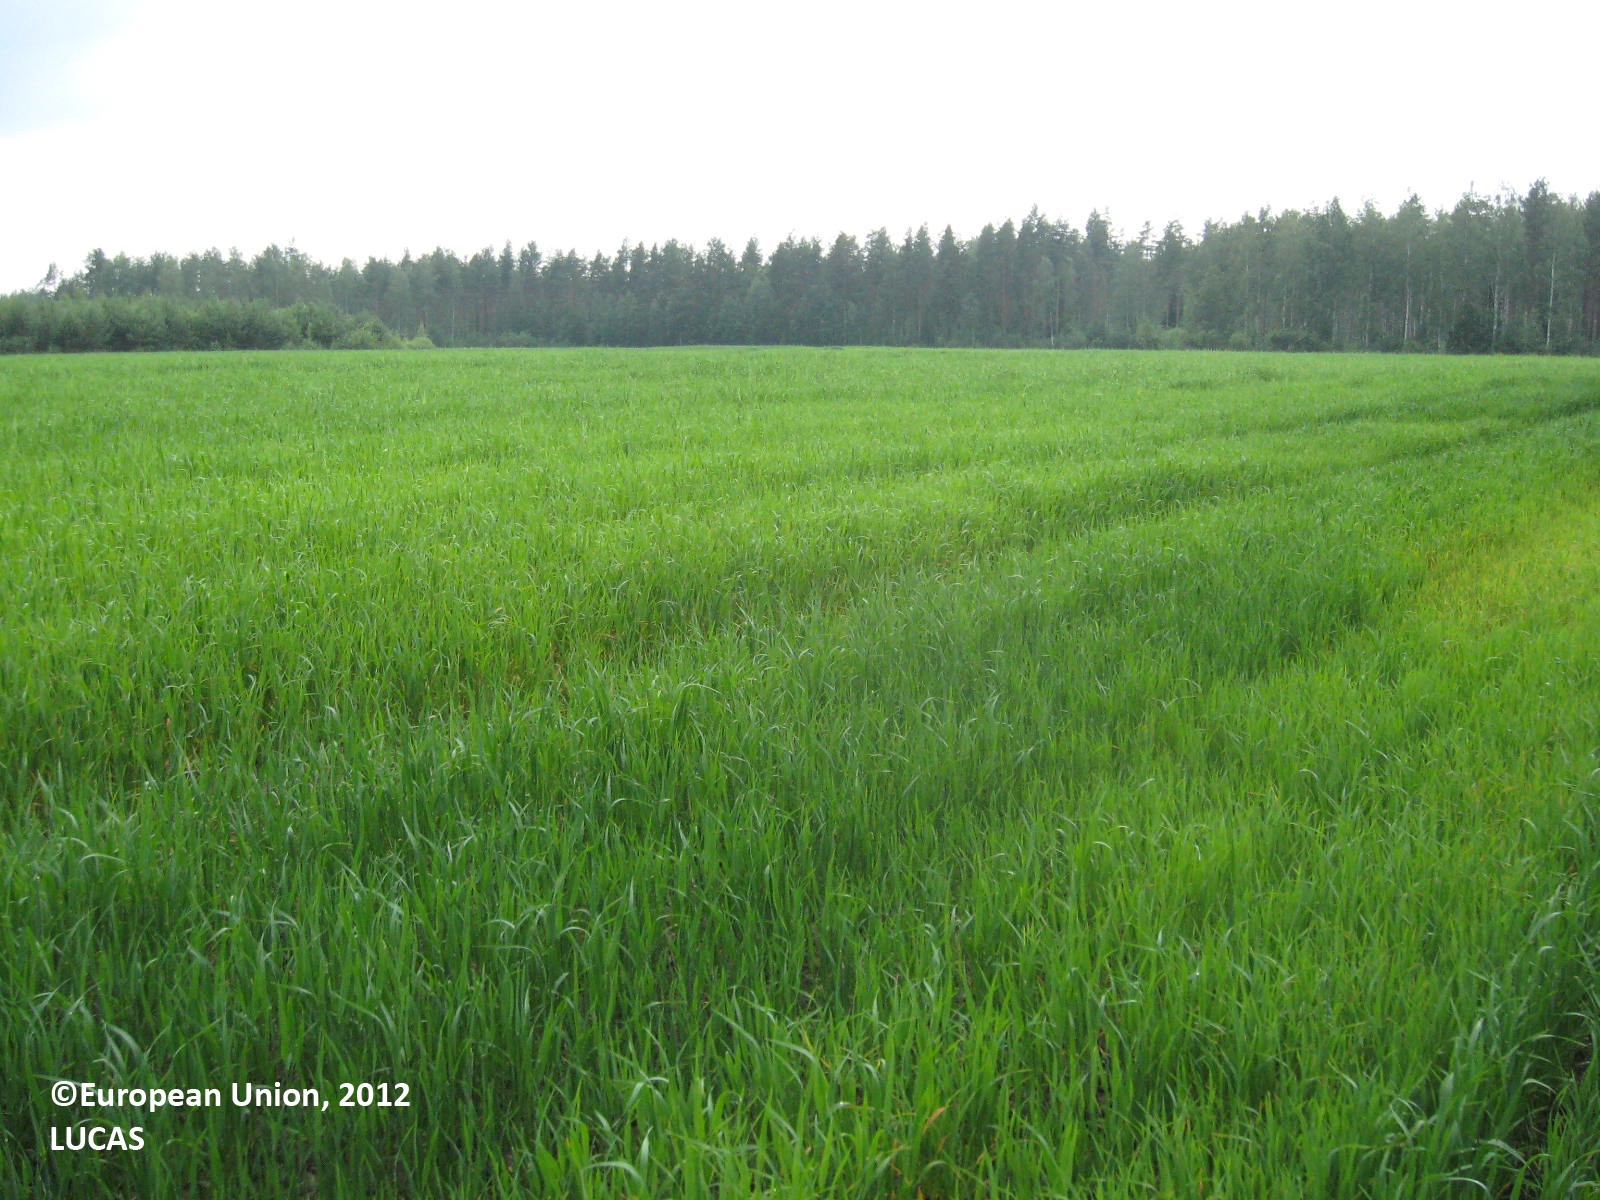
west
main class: Cropland
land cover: Oats
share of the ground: > 75 %
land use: Agriculture (excluding fallow land and kitchen gardens)
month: July
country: FI
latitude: 62.3811
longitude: 22.7247
